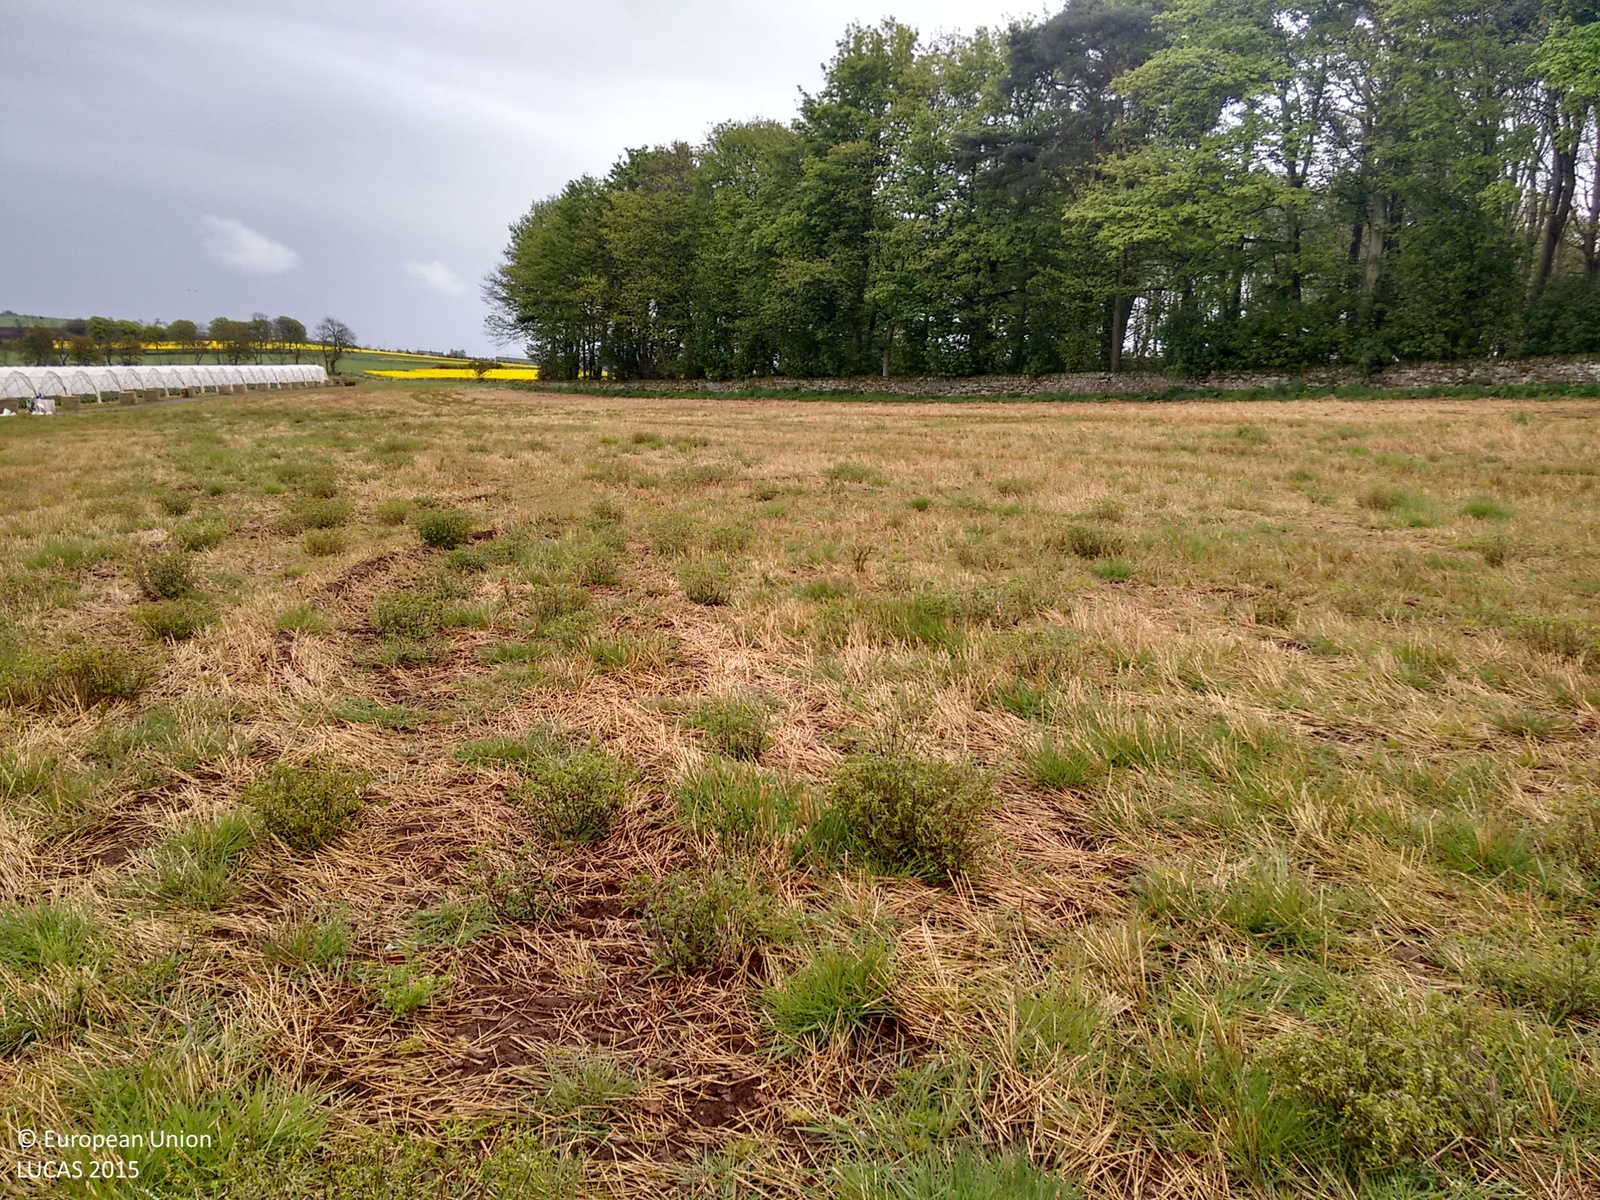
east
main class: Grassland
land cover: Grassland without tree/shrub cover
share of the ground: > 75 %
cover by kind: herbaceous plants 100 %
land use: Agriculture (excluding fallow land and kitchen gardens)
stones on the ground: 10 - 25 %
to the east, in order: Grassland without tree/shrub cover; Dry stone walls; Broadleaved woodland; Fences; Grass margins; Rape and turnip rape
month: May
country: GB
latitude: 56.6215
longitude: -2.5910
